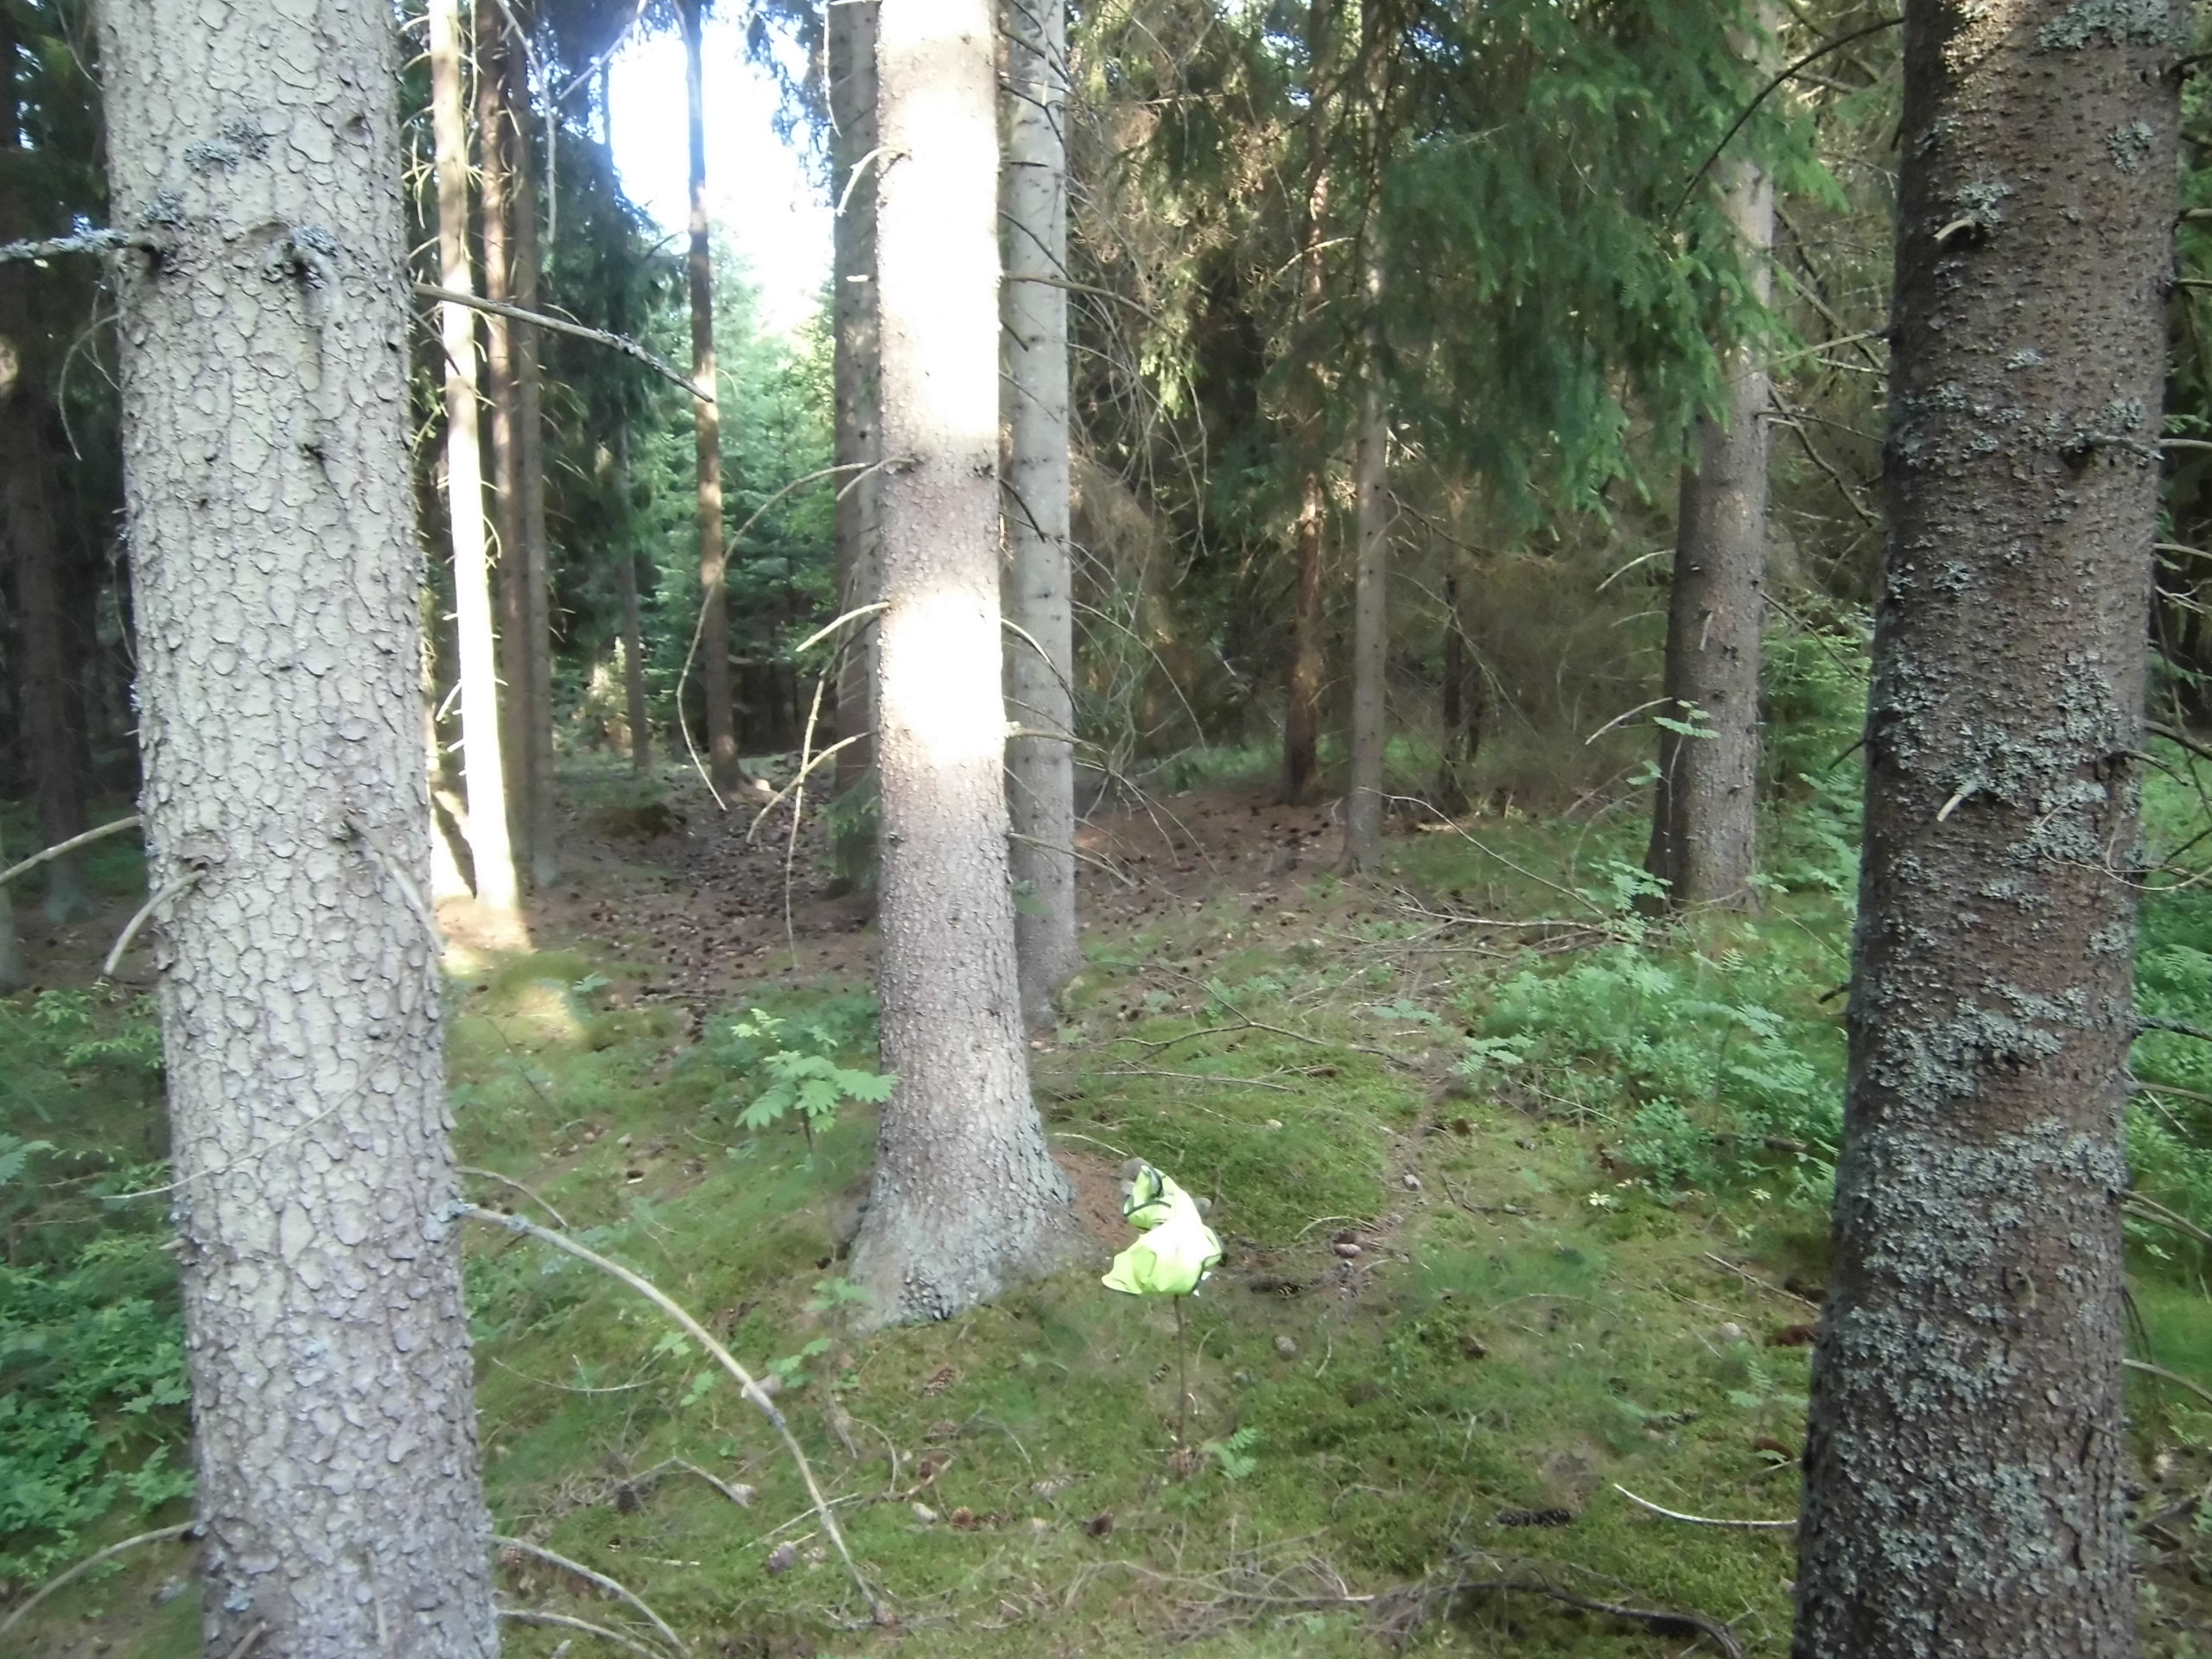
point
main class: Woodland
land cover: Spruce dominated coniferous woodland
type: boreal forest
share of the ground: > 75 %
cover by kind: coniferous forest trees 75 %, lichens and mosses 10 %, broadleaved forest trees 5 %, shrubs 5 %, unconsolidated bare surface 5 %
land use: Forestry
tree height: > 5 m
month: July
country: SE
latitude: 57.3614
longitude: 14.7340
